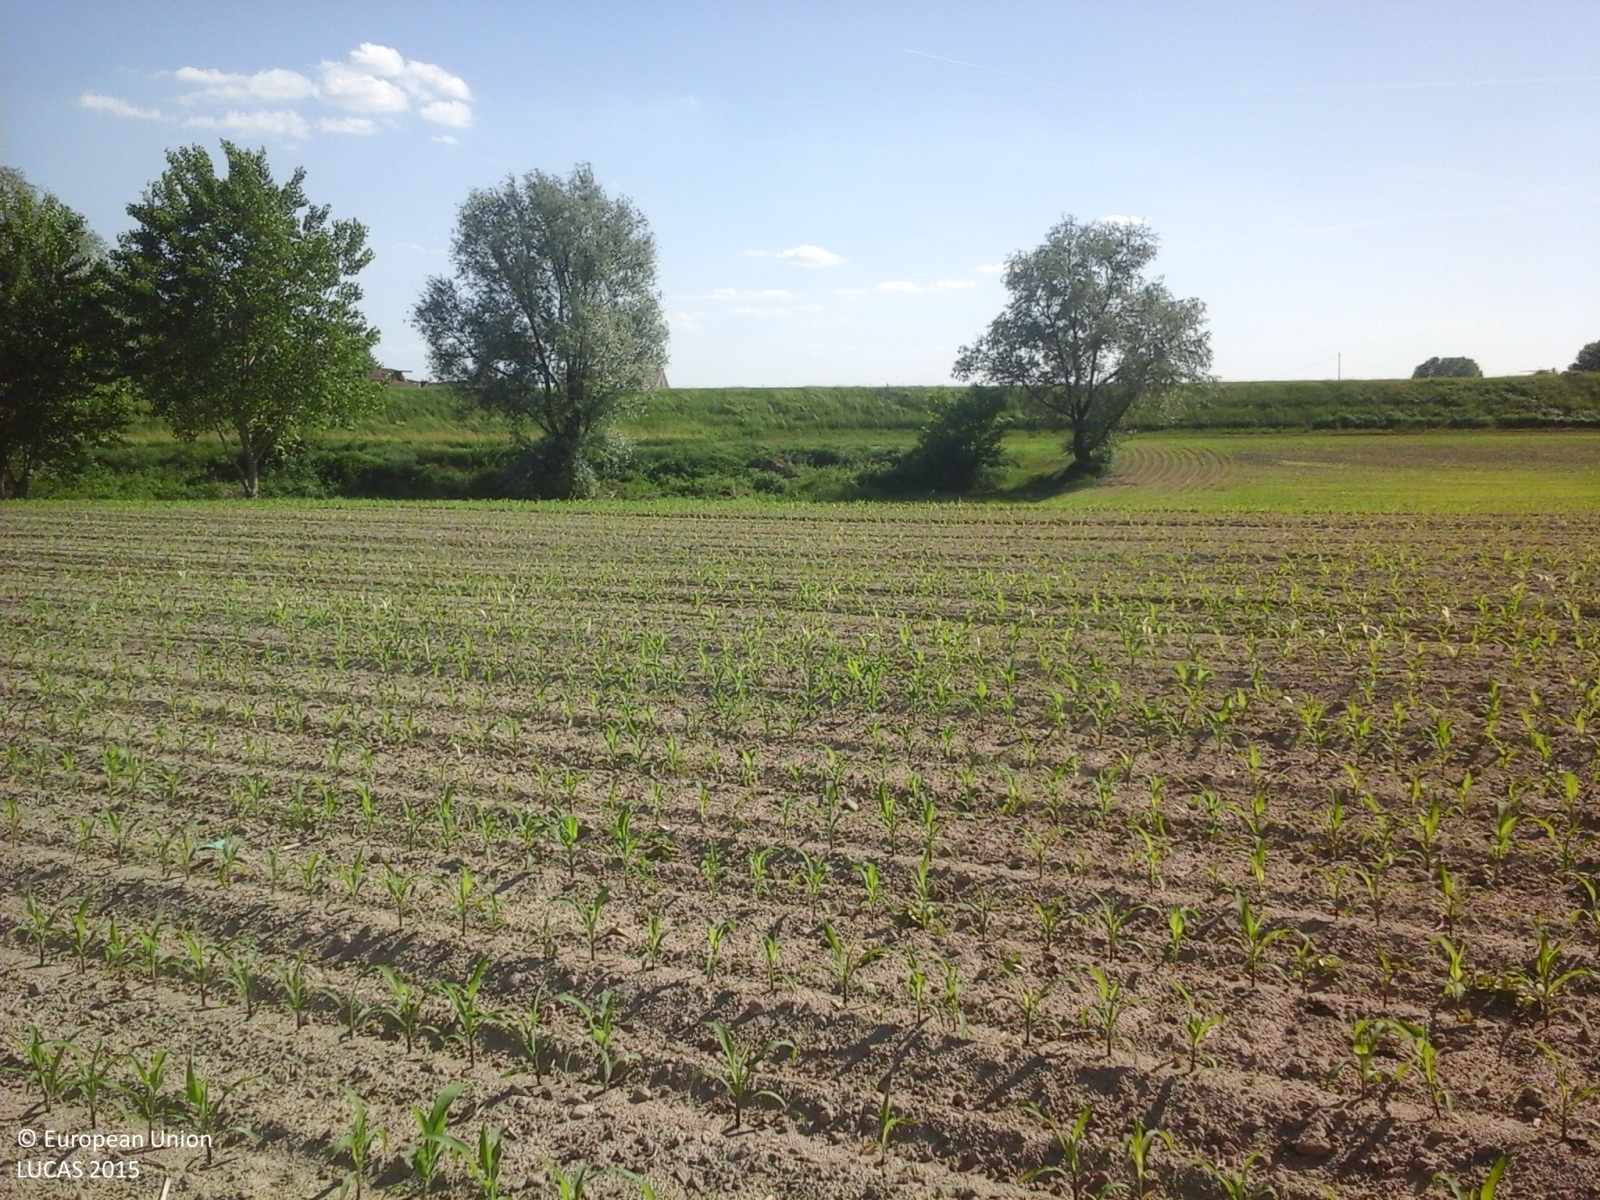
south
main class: Cropland
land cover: Maize
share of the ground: < 10 %
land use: Agriculture (excluding fallow land and kitchen gardens)
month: May
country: IT
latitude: 45.0501
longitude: 10.8744
